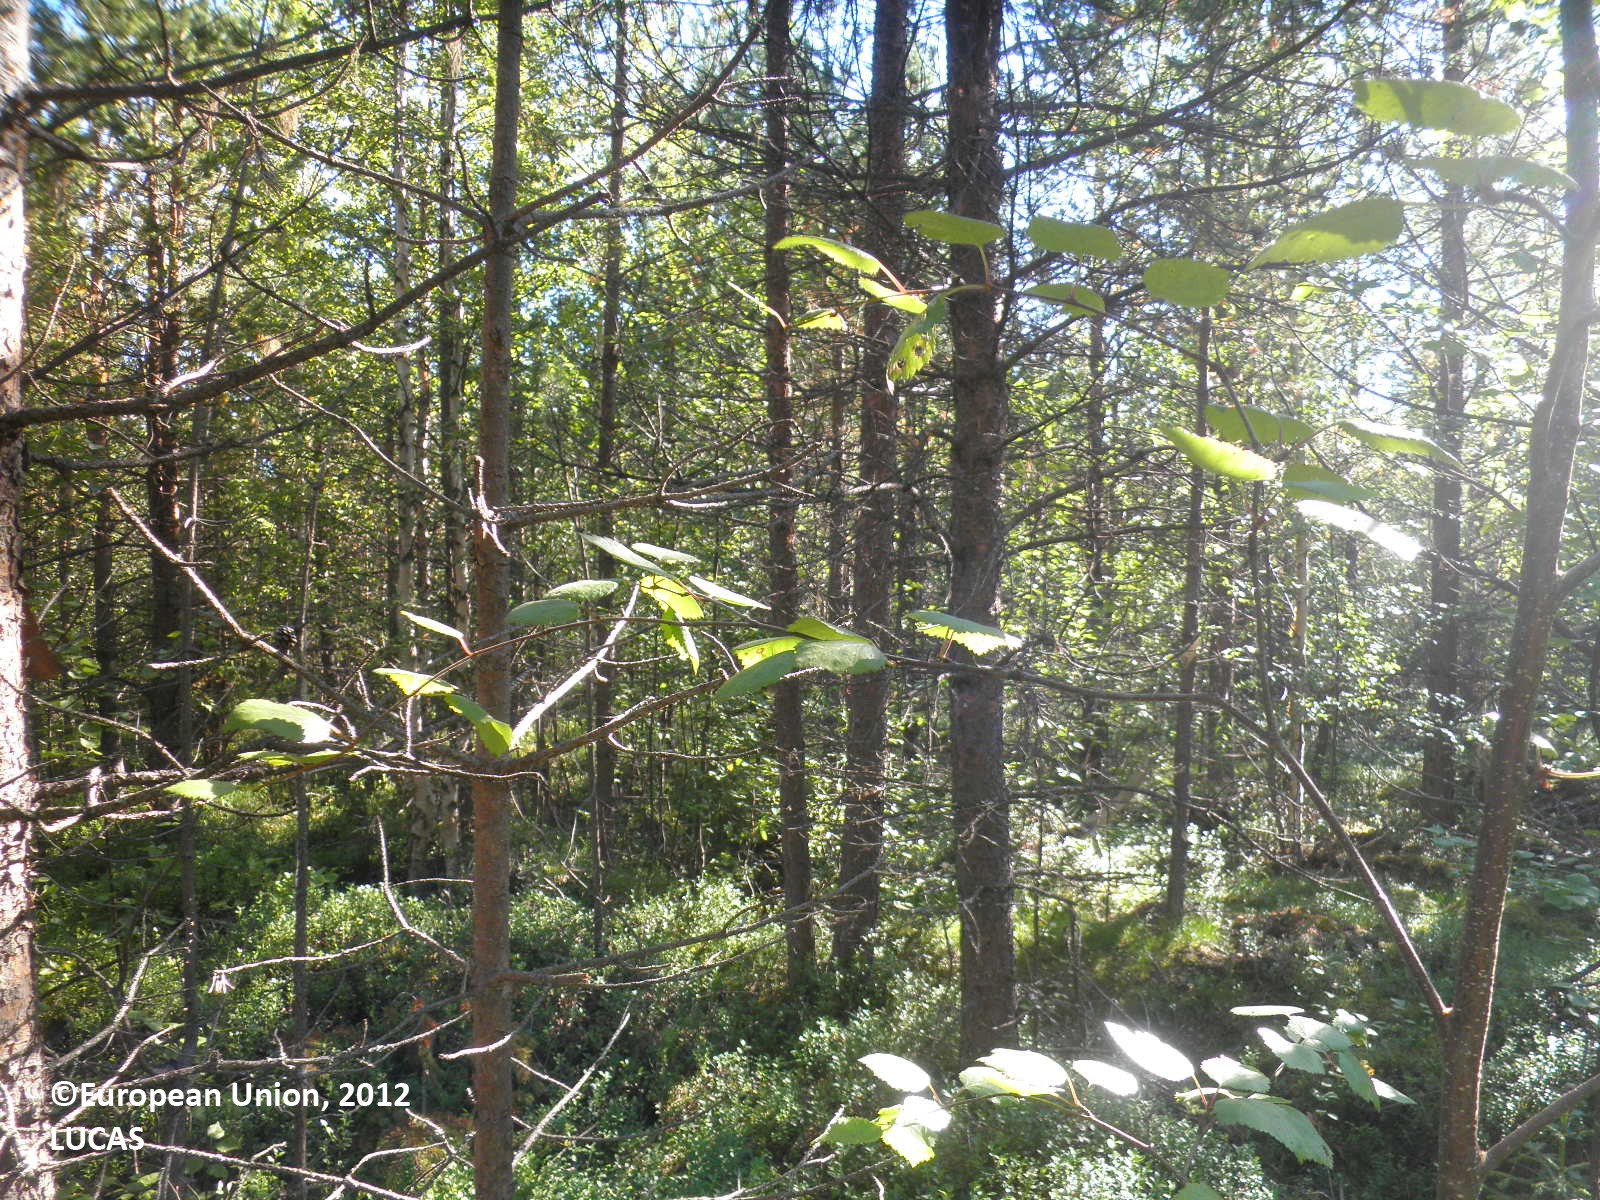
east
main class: Woodland
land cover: Pine dominated mixed woodland
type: boreal forest
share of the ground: 50 - 75 %
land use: Forestry
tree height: > 5 m
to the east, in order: Pine dominated mixed woodland; Ditches and canals; Pine dominated mixed woodland; Ditches and canals; Pine dominated mixed woodland; Ditches and canals; Pine dominated mixed woodland; Tracks; Broadleaved woodland; Spruce dominated mixed woodland; Shrubland with sparse tree cover; Broadleaved woodland
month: August
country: FI
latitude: 67.6556
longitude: 25.4372
